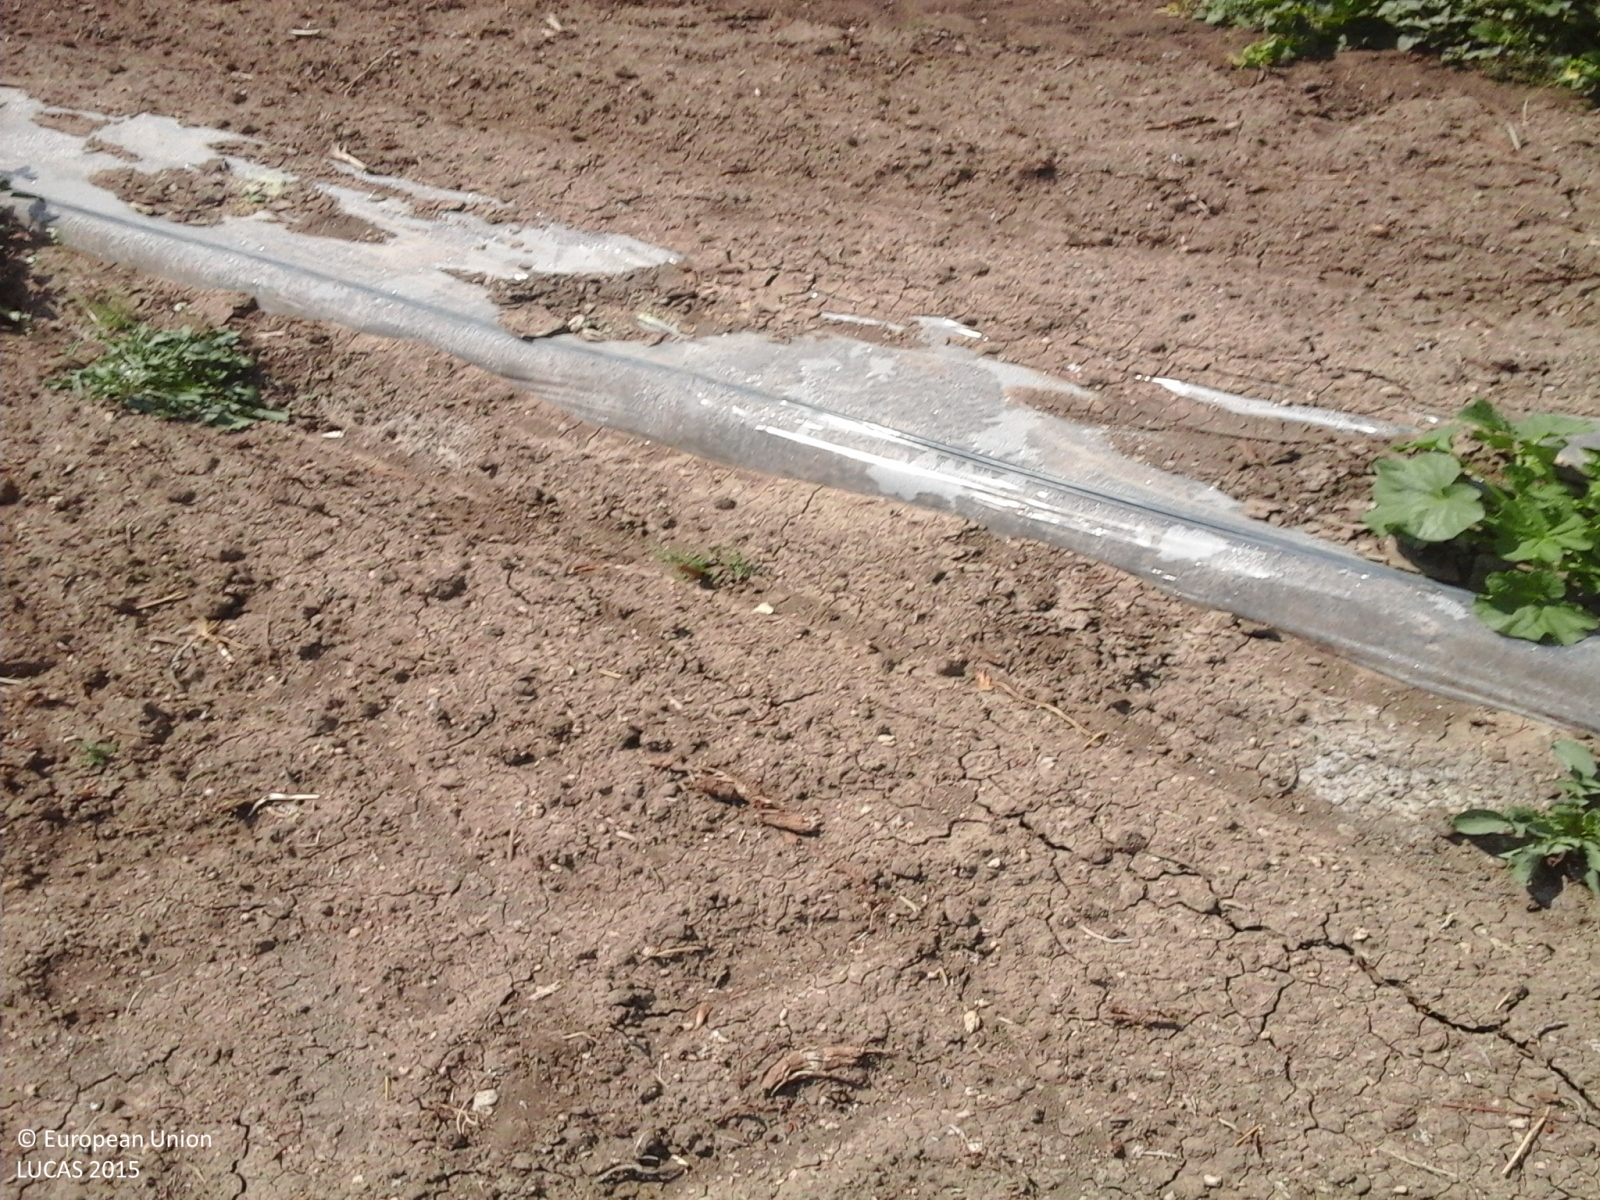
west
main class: Cropland
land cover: Other fresh vegetables
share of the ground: > 75 %
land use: Agriculture (excluding fallow land and kitchen gardens)
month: July
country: IT
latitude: 37.1904
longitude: 14.4156
